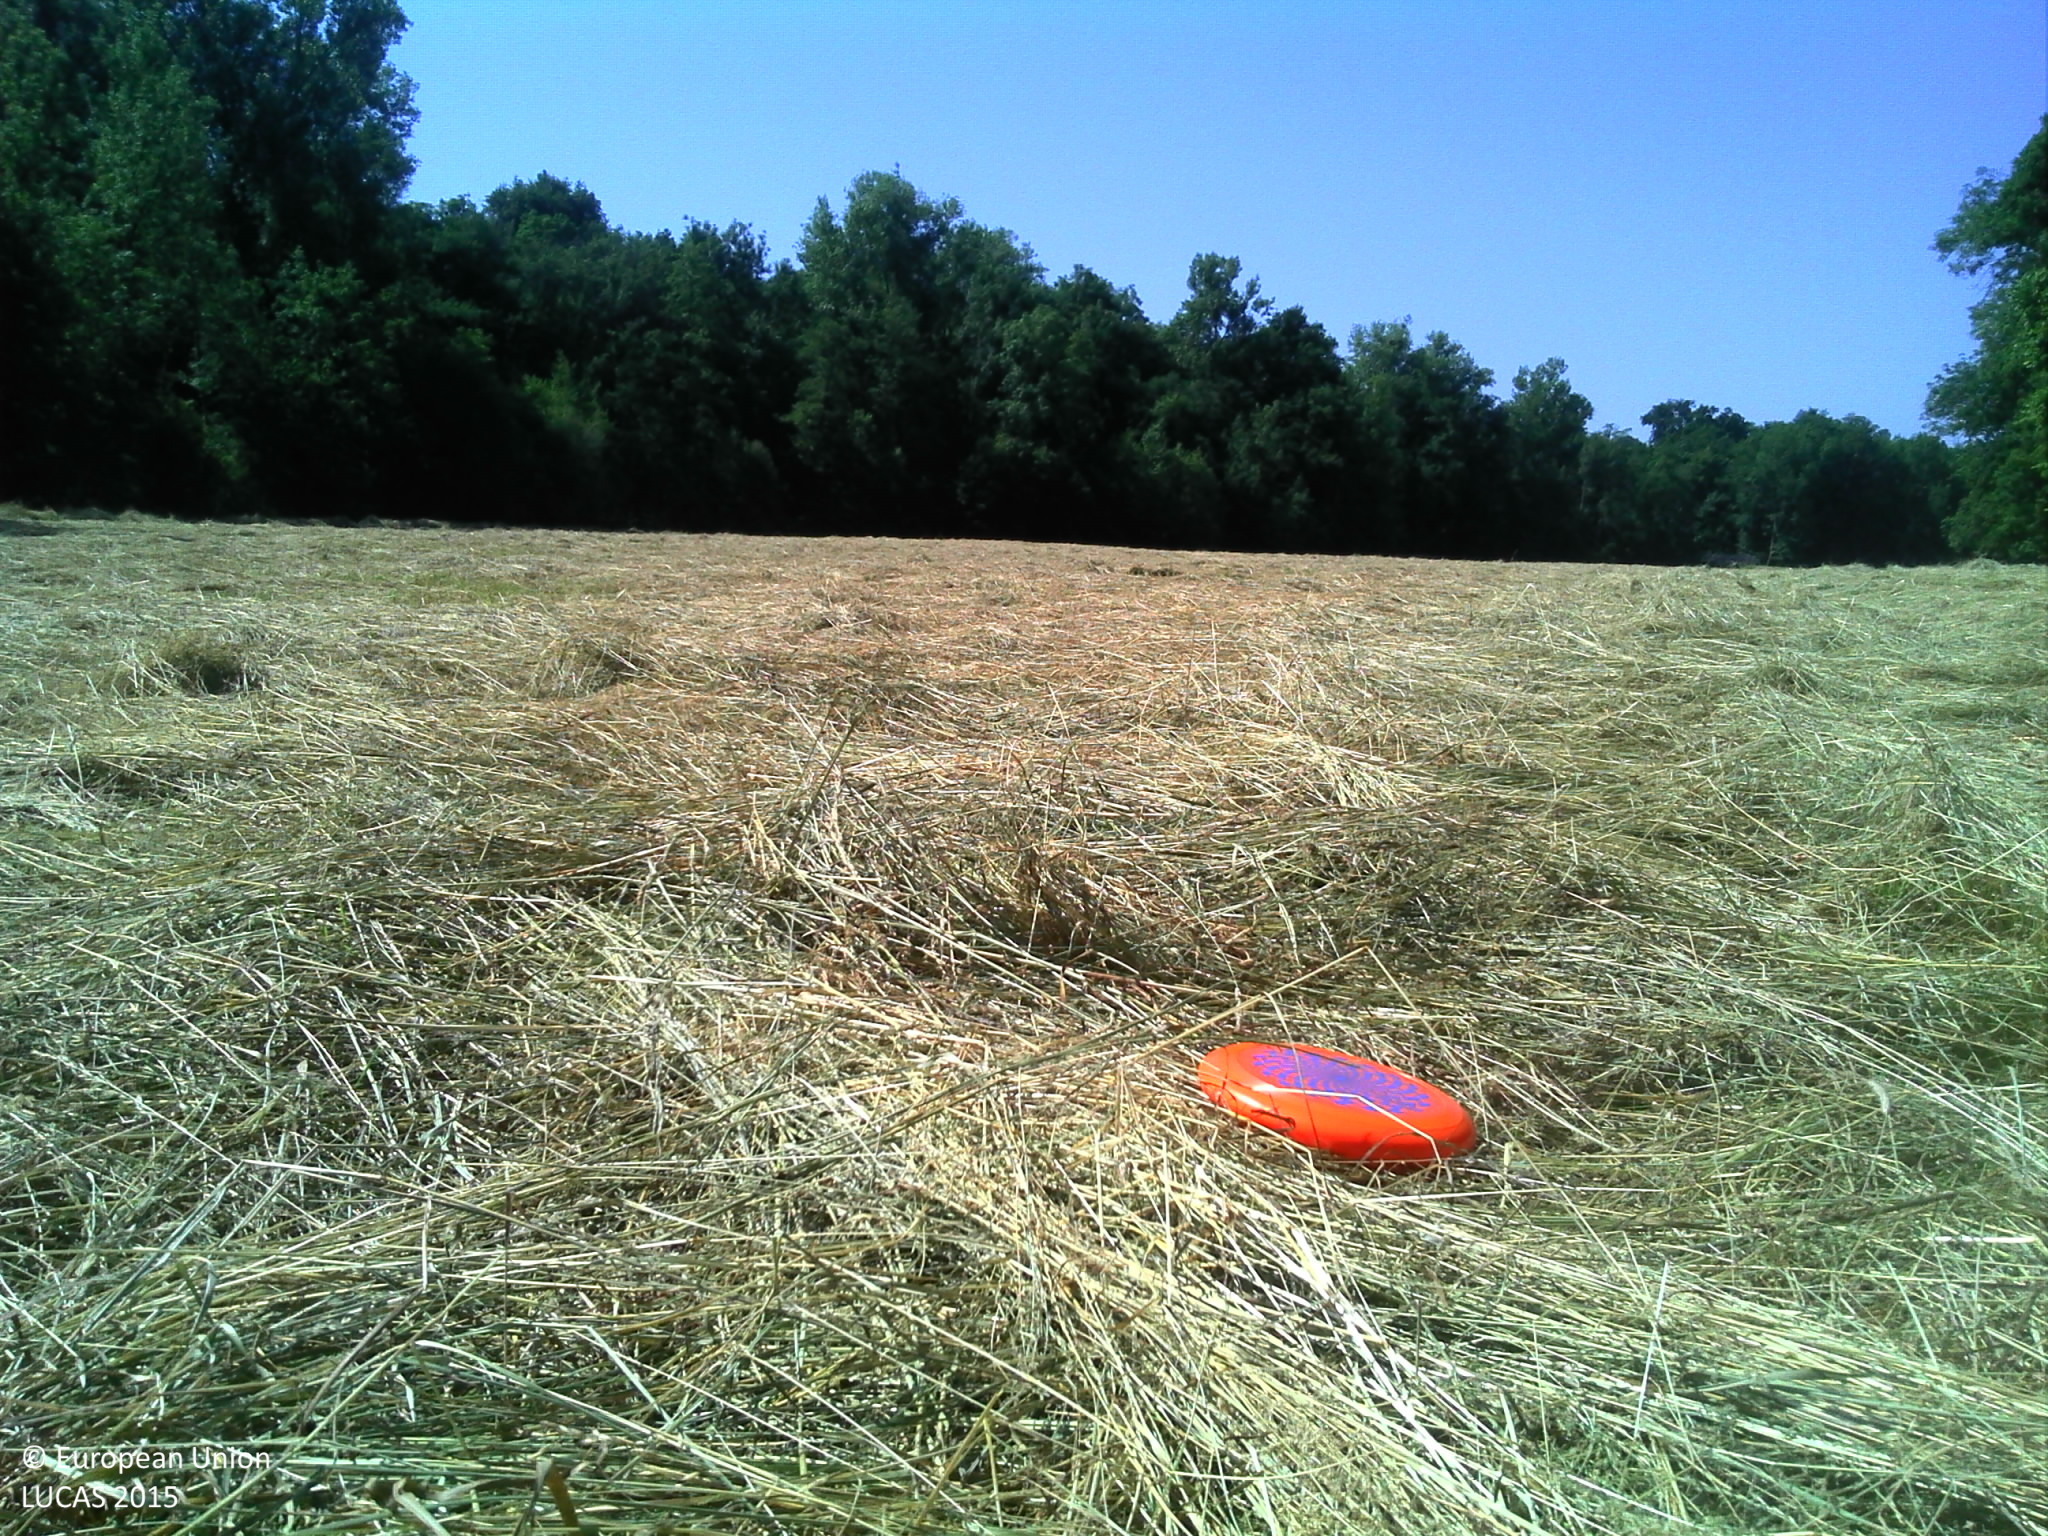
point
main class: Grassland
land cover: Grassland without tree/shrub cover
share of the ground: > 75 %
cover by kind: herbaceous plants 100 %
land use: Agriculture (excluding fallow land and kitchen gardens)
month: June
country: FR
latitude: 48.3968
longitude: 7.6643
